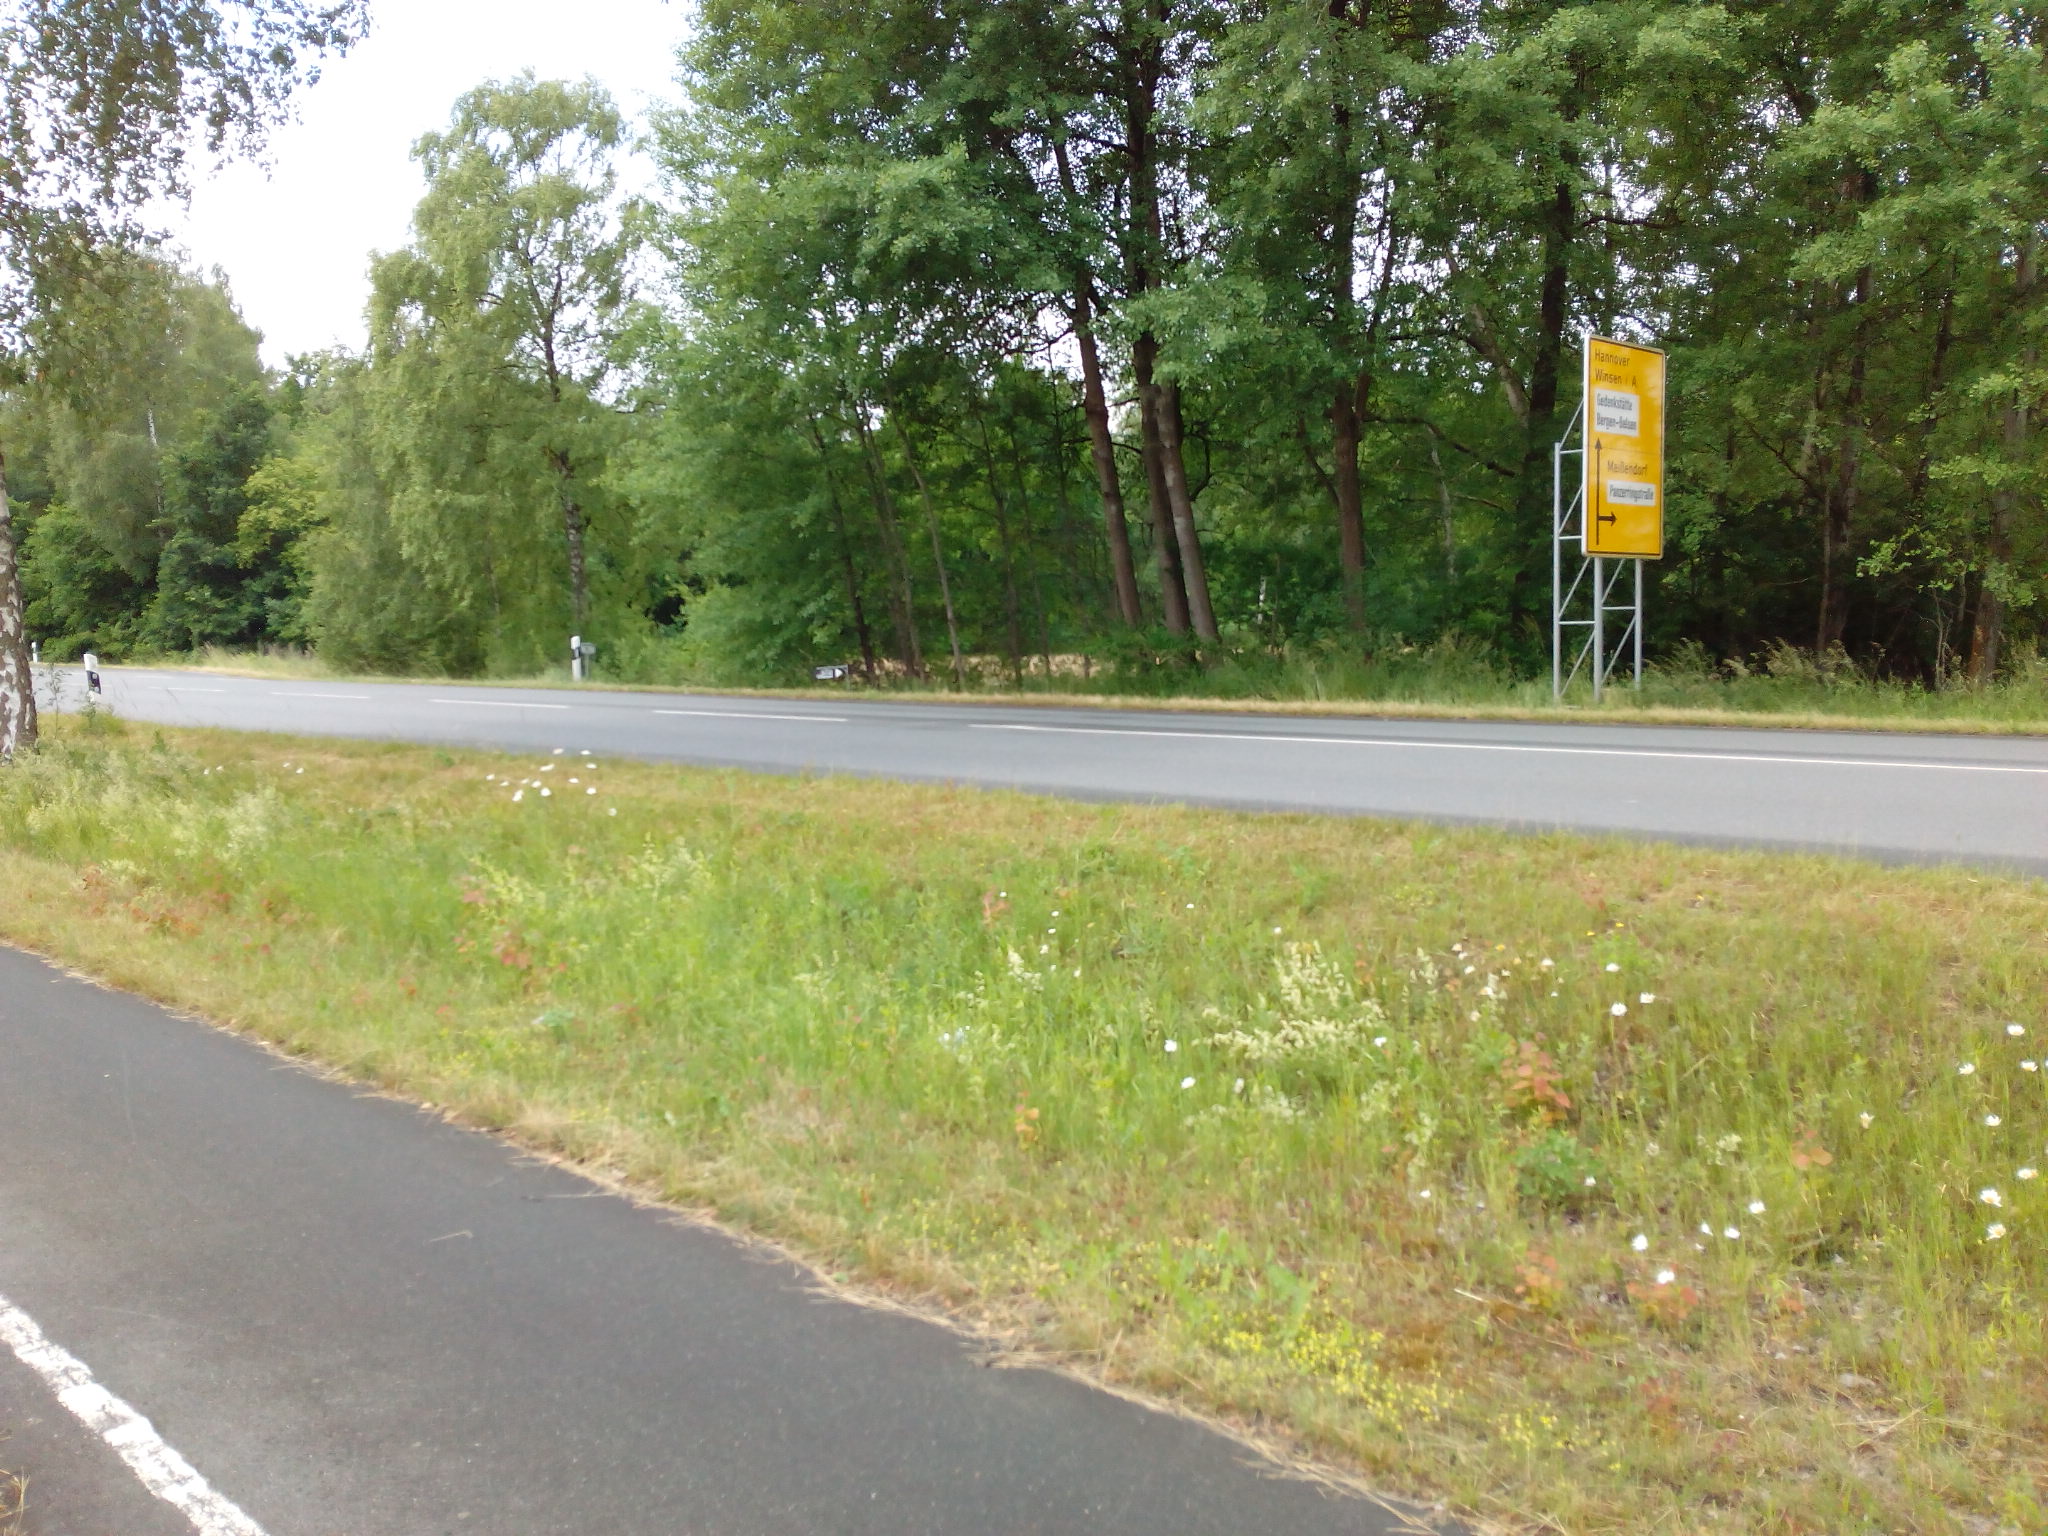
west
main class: Cropland
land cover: Barley
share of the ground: > 75 %
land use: Agriculture (excluding fallow land and kitchen gardens)
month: June
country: DE
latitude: 52.7728
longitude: 9.9259
